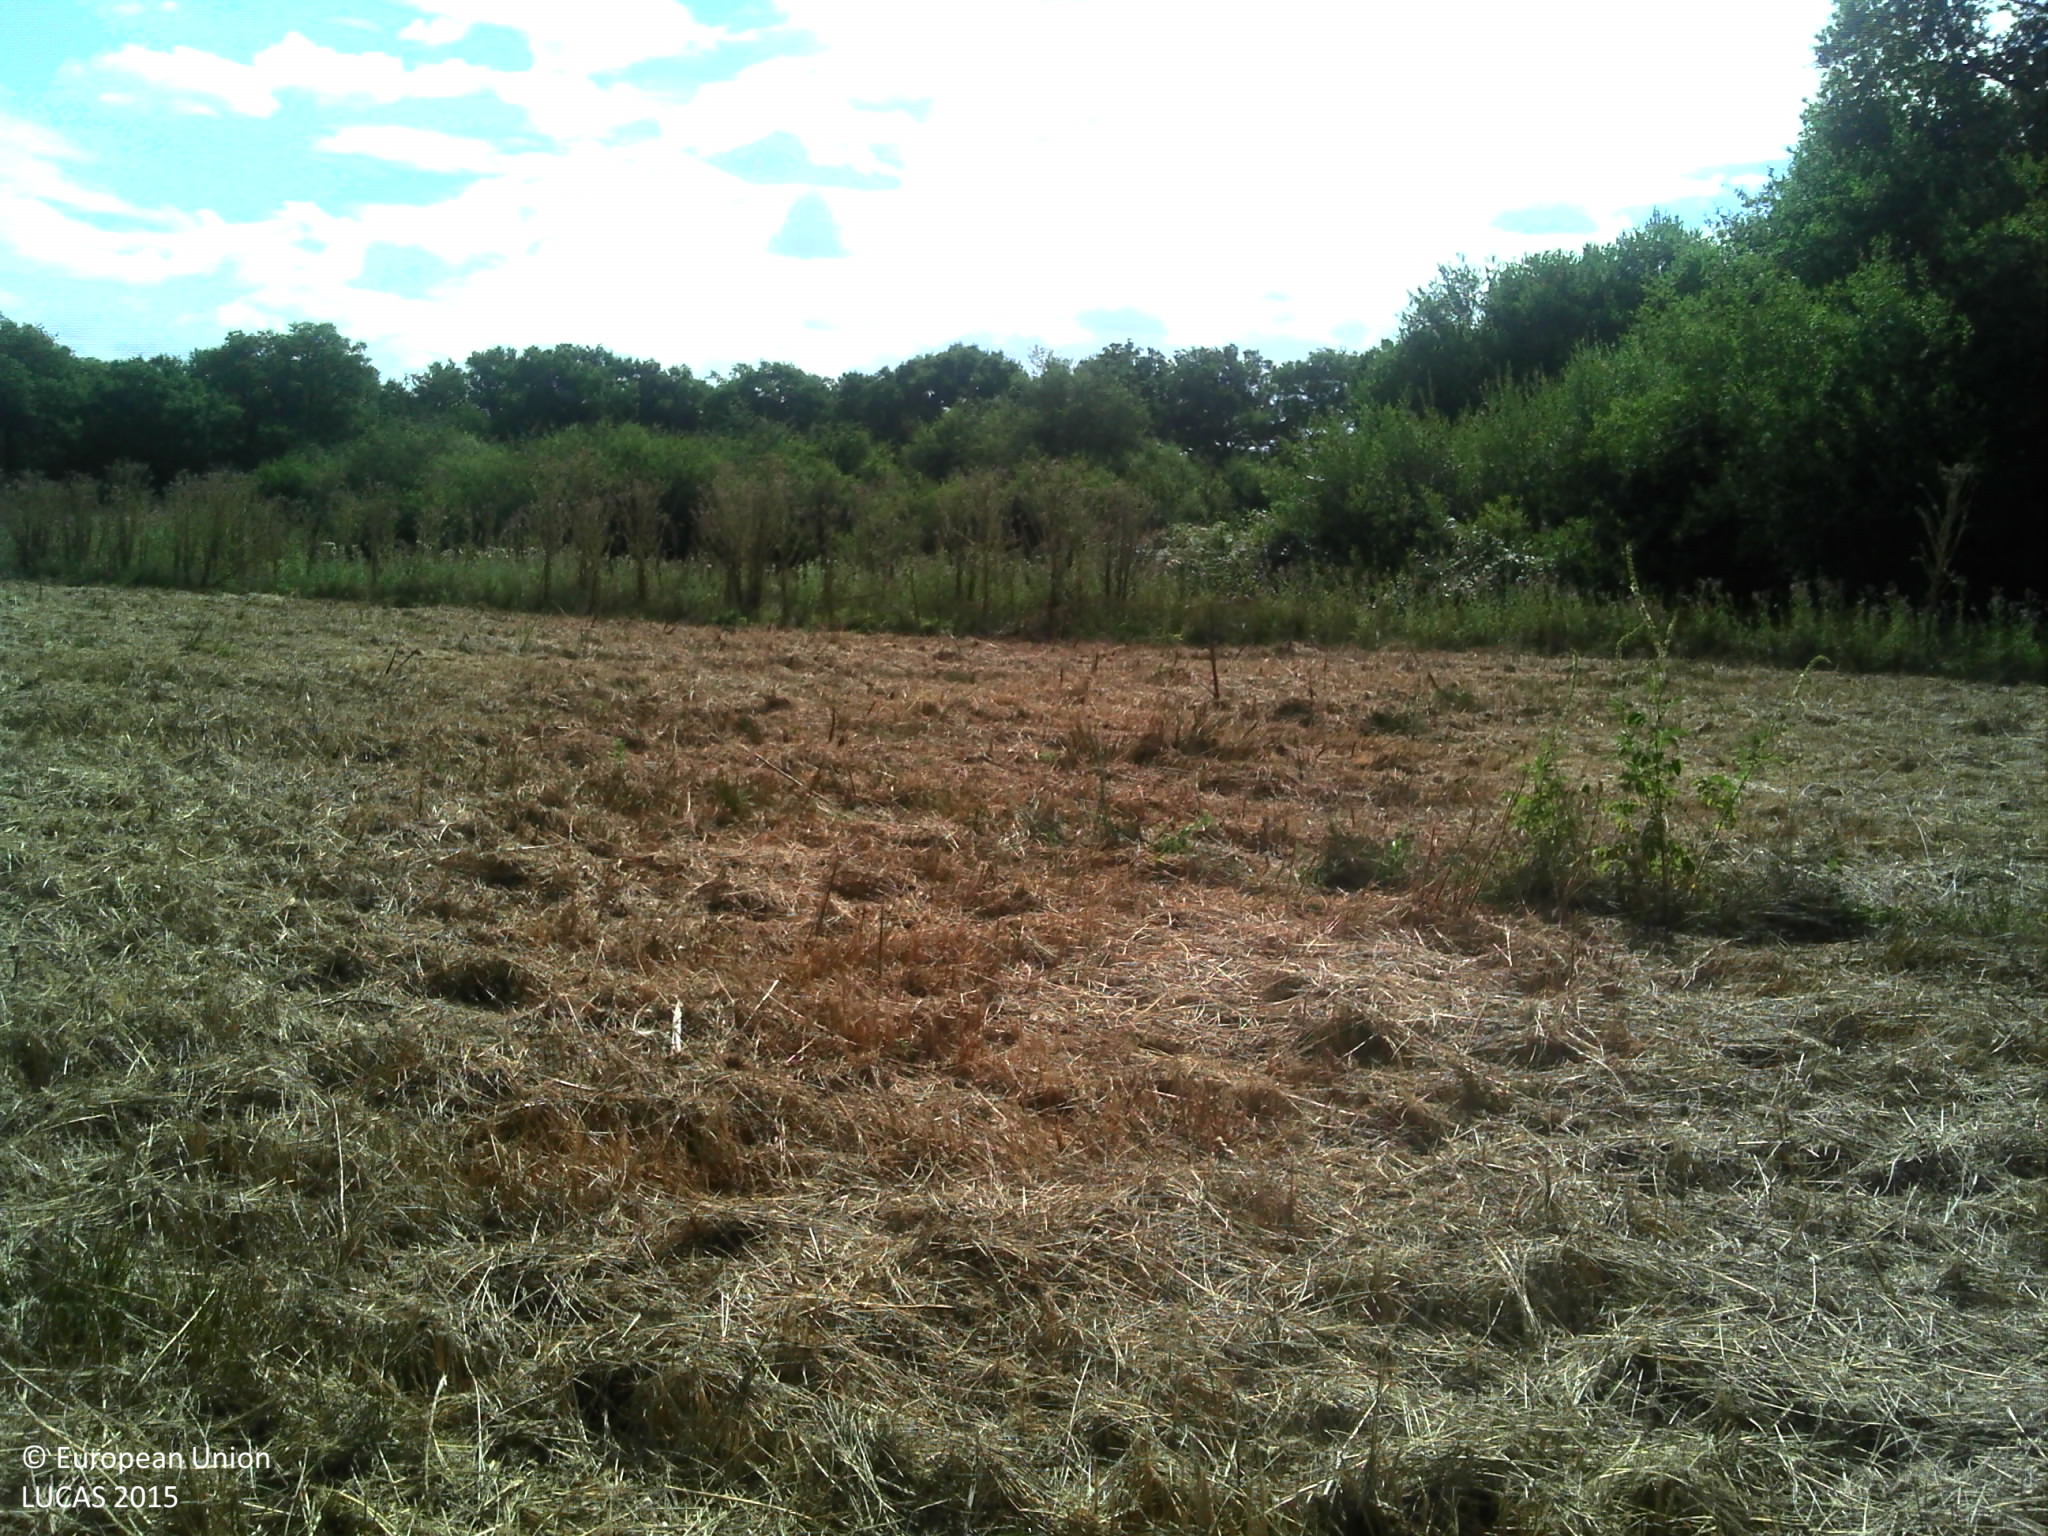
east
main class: Grassland
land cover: Grassland without tree/shrub cover
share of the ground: > 75 %
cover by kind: herbaceous plants 100 %
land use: Agriculture (excluding fallow land and kitchen gardens)
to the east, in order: Grassland without tree/shrub cover; Spontaneously vegetated surfaces; Inland marshes; Spontaneously vegetated surfaces; Broadleaved woodland; Fences; Grassland without tree/shrub cover
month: July
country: FR
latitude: 46.2780
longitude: 1.2028
